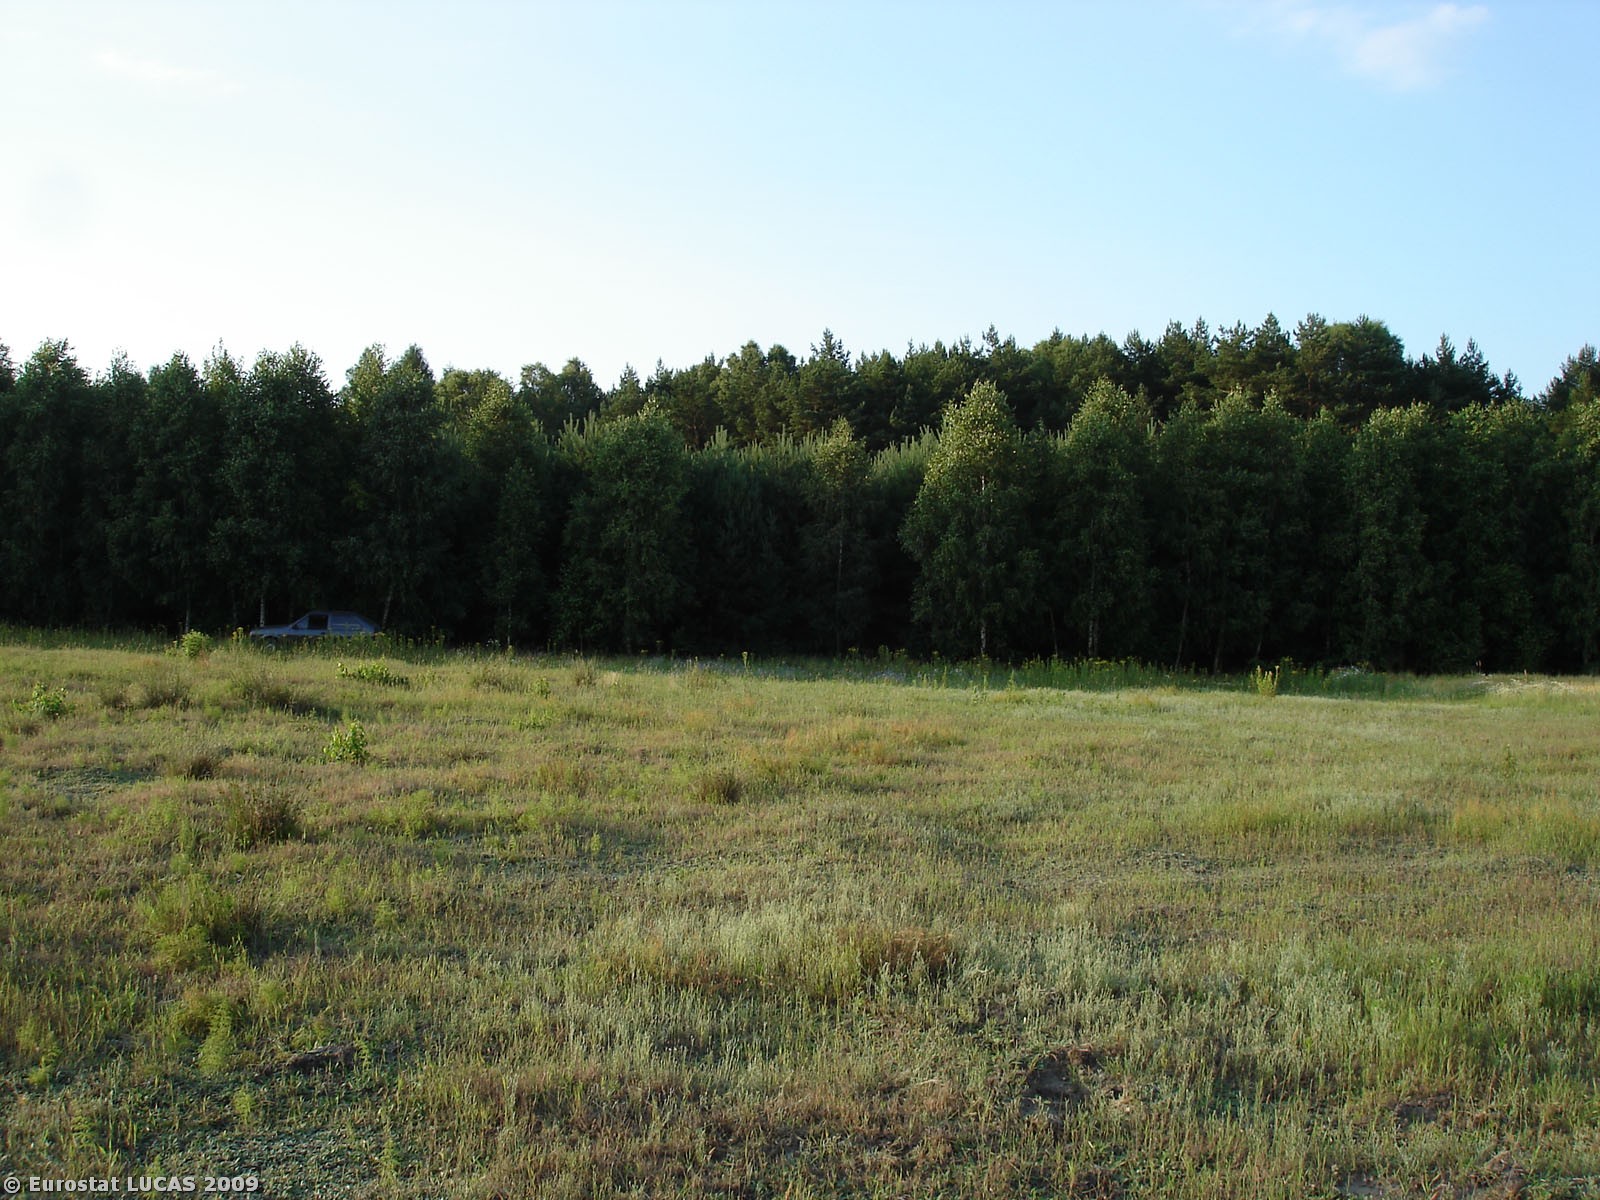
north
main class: Grassland
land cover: Grassland without tree/shrub cover
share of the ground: > 75 %
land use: Agriculture (excluding fallow land and kitchen gardens)
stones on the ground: < 10 %
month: July
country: PL
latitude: 50.8951
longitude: 19.8844
